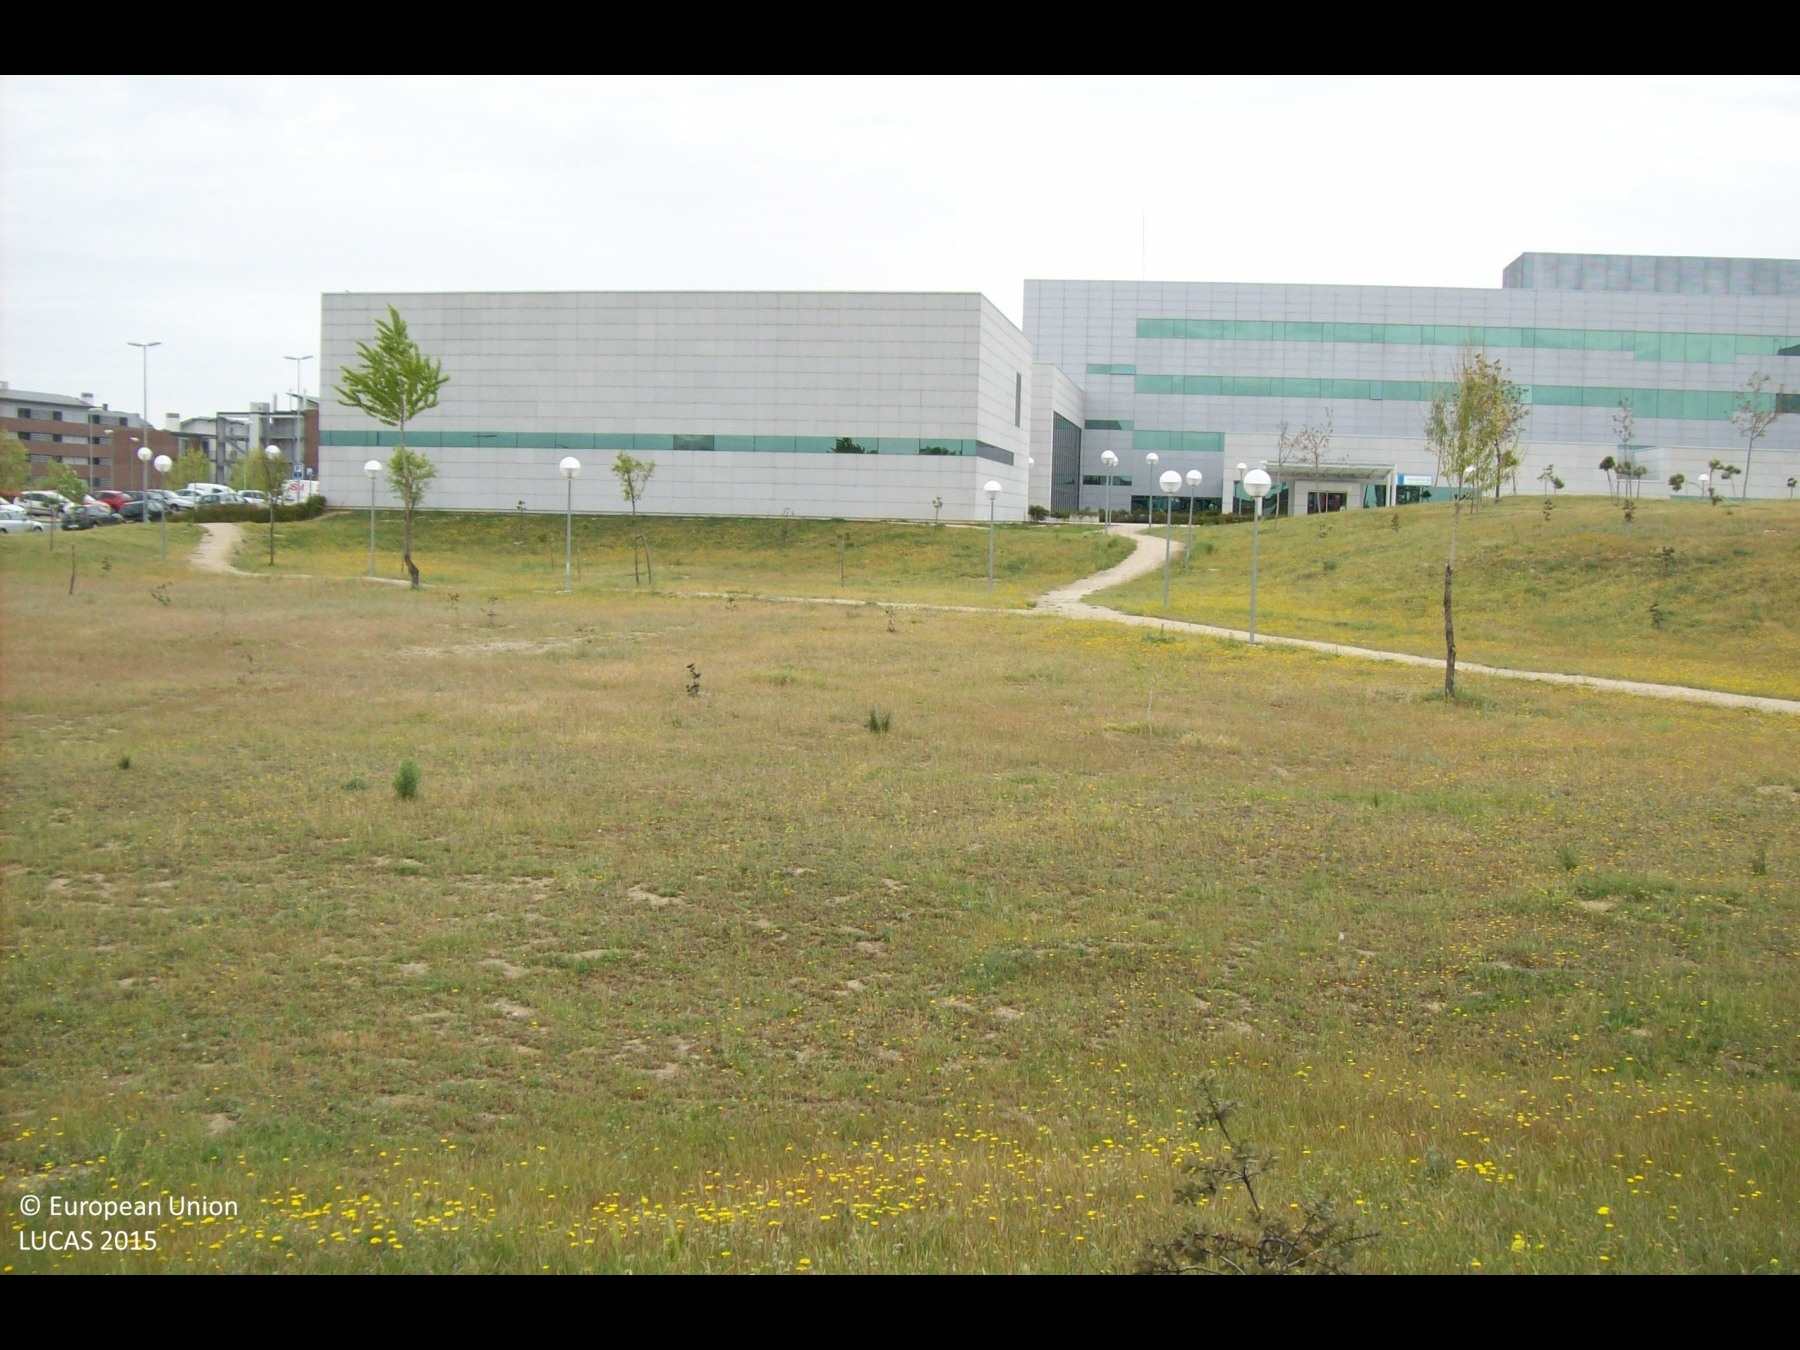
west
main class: Grassland
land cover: Grassland with sparse tree/shrub cover
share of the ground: > 75 %
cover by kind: herbaceous plants 95 %, coniferous forest trees 5 %
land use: Community services
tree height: < 5 m
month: April
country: ES
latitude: 40.4495
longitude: -3.8710
